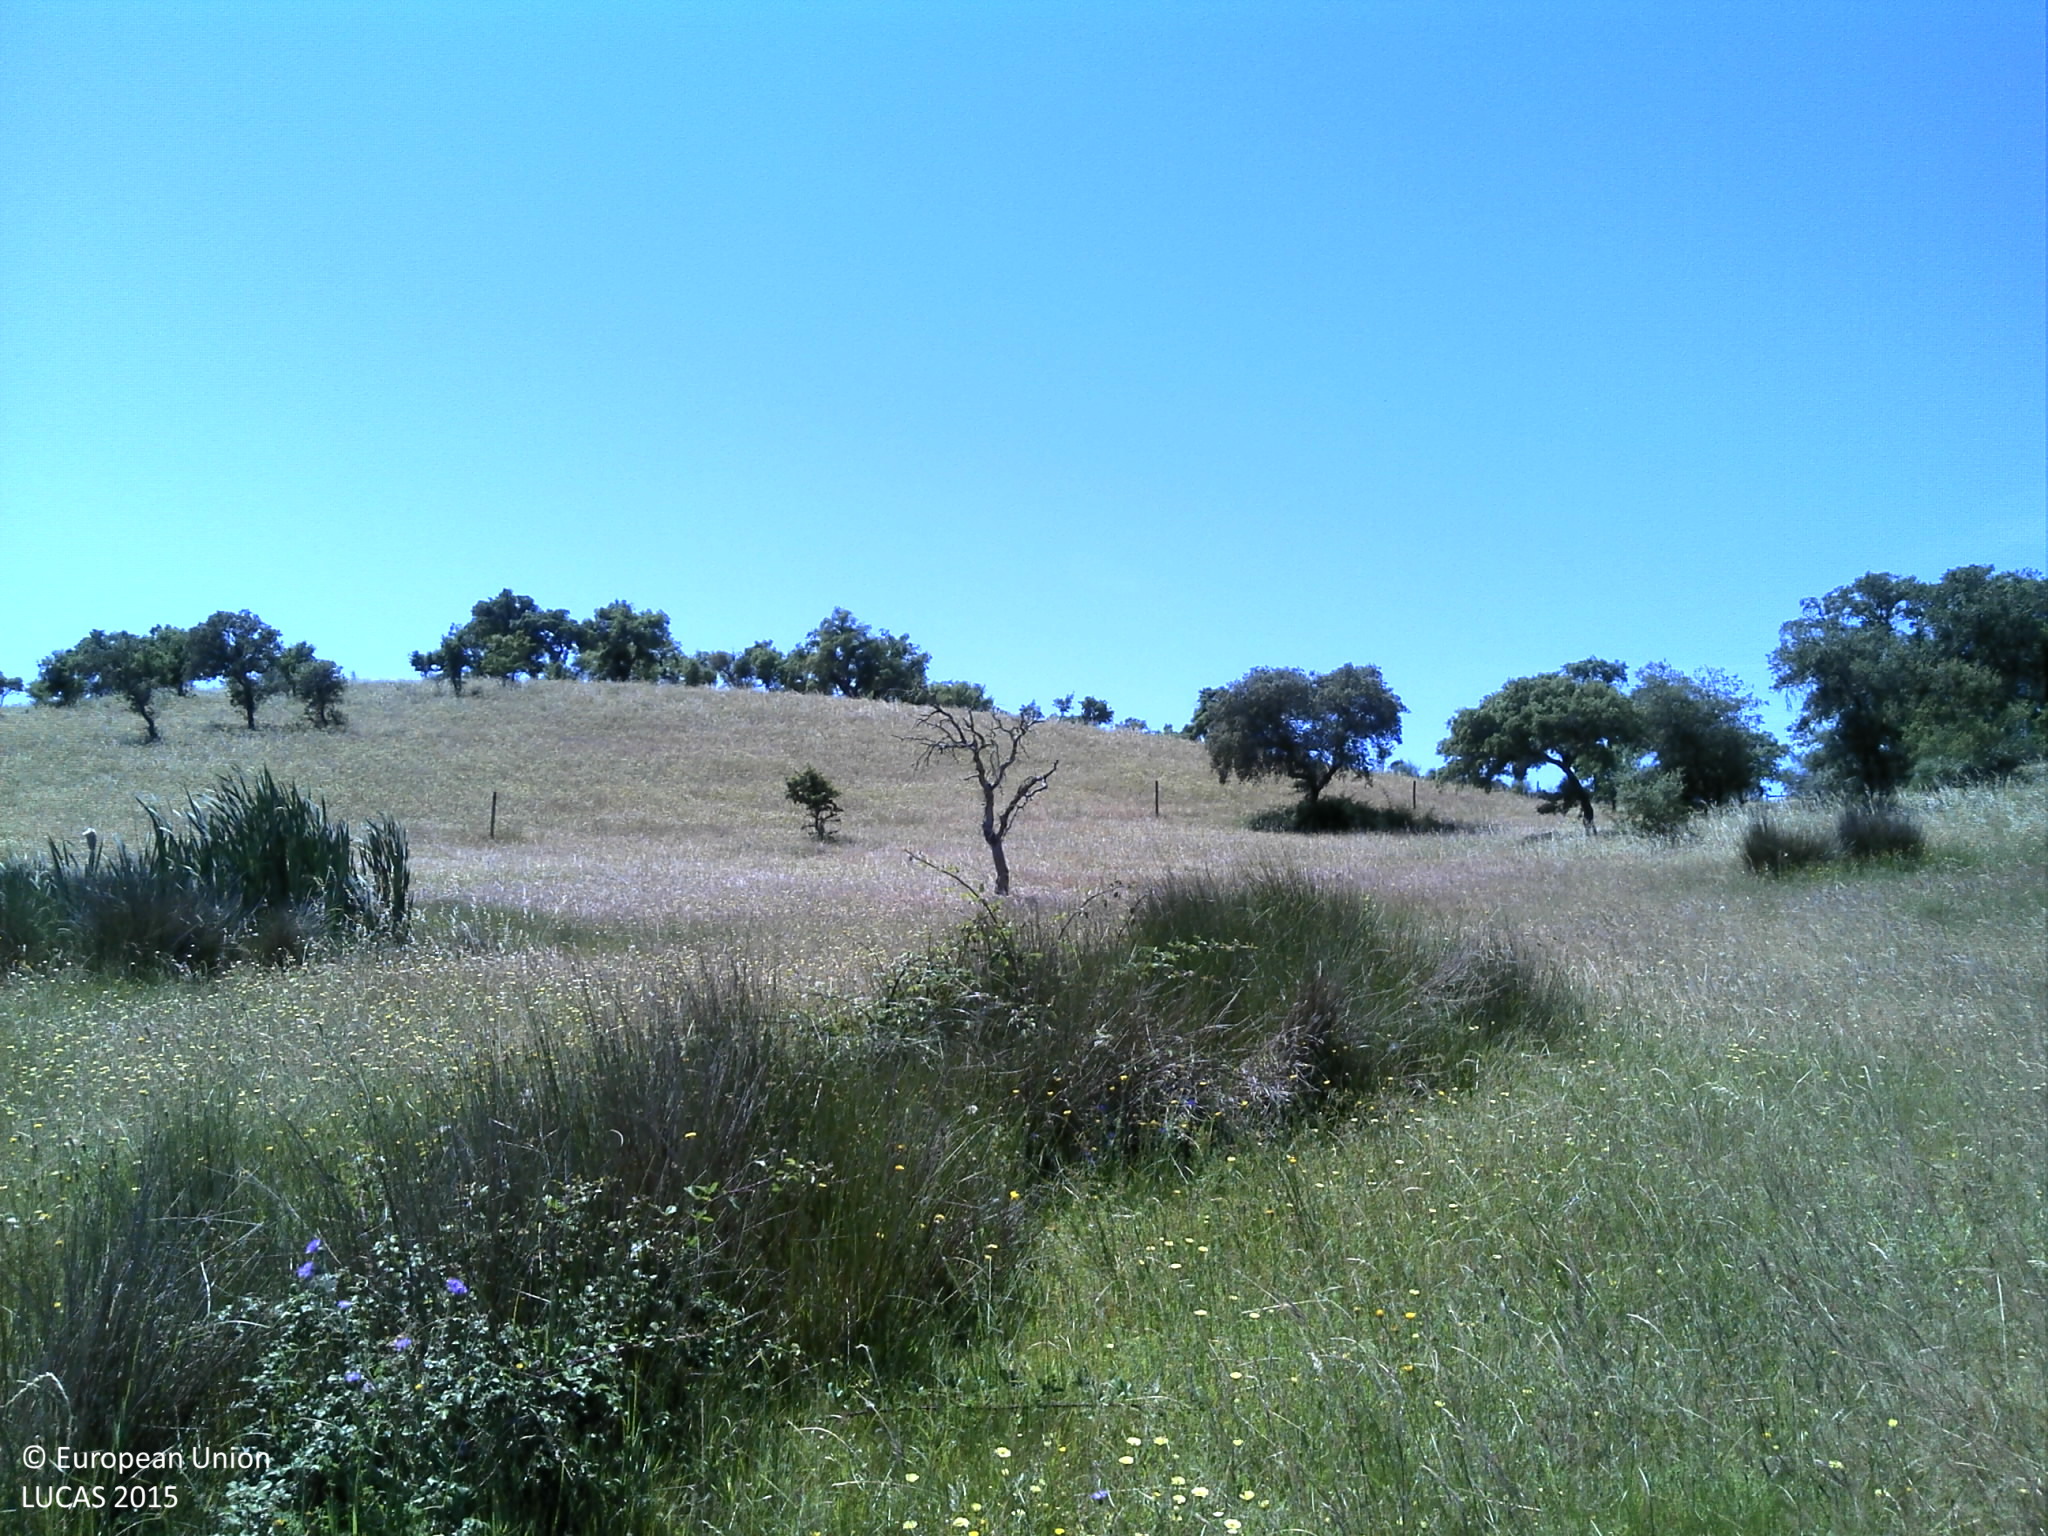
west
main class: Grassland
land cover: Grassland without tree/shrub cover
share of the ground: 50 - 75 %
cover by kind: herbaceous plants 60 %, unconsolidated bare surface 40 %
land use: Agriculture (excluding fallow land and kitchen gardens)
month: May
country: PT
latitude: 39.2973
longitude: -7.6604
